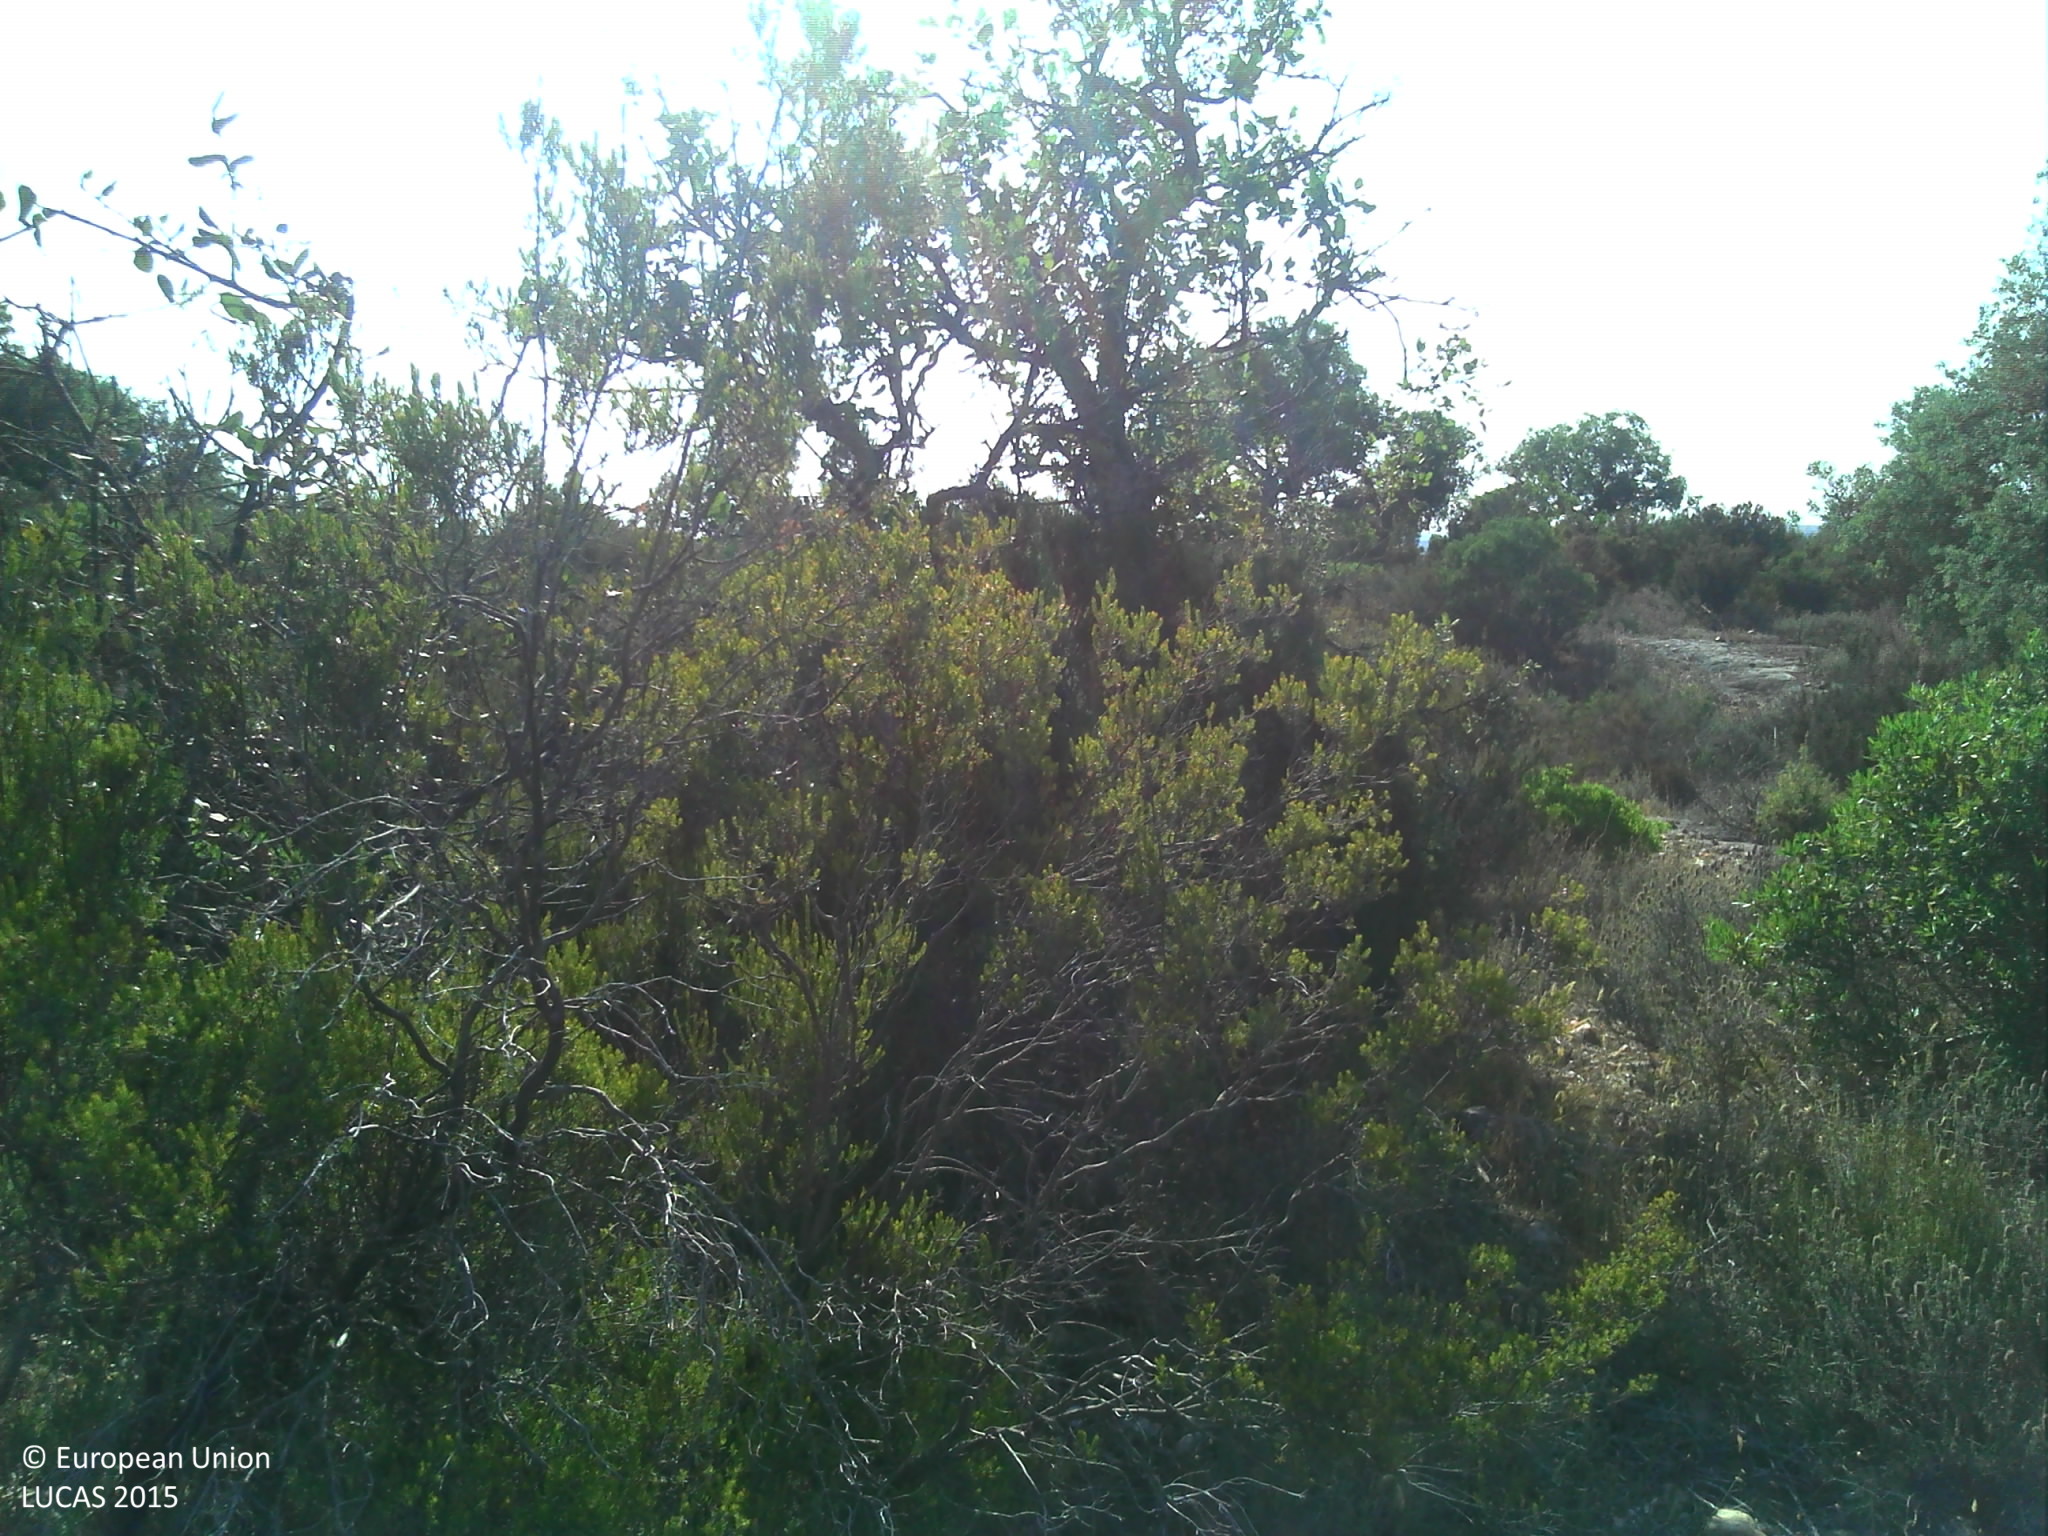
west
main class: Shrubland
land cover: Shrubland with sparse tree cover
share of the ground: > 75 %
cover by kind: shrubs 95 %, broadleaved forest trees 5 %
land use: Semi-natural and natural areas not in use
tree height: > 5 m
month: July
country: FR
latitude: 43.3488
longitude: 6.3943
